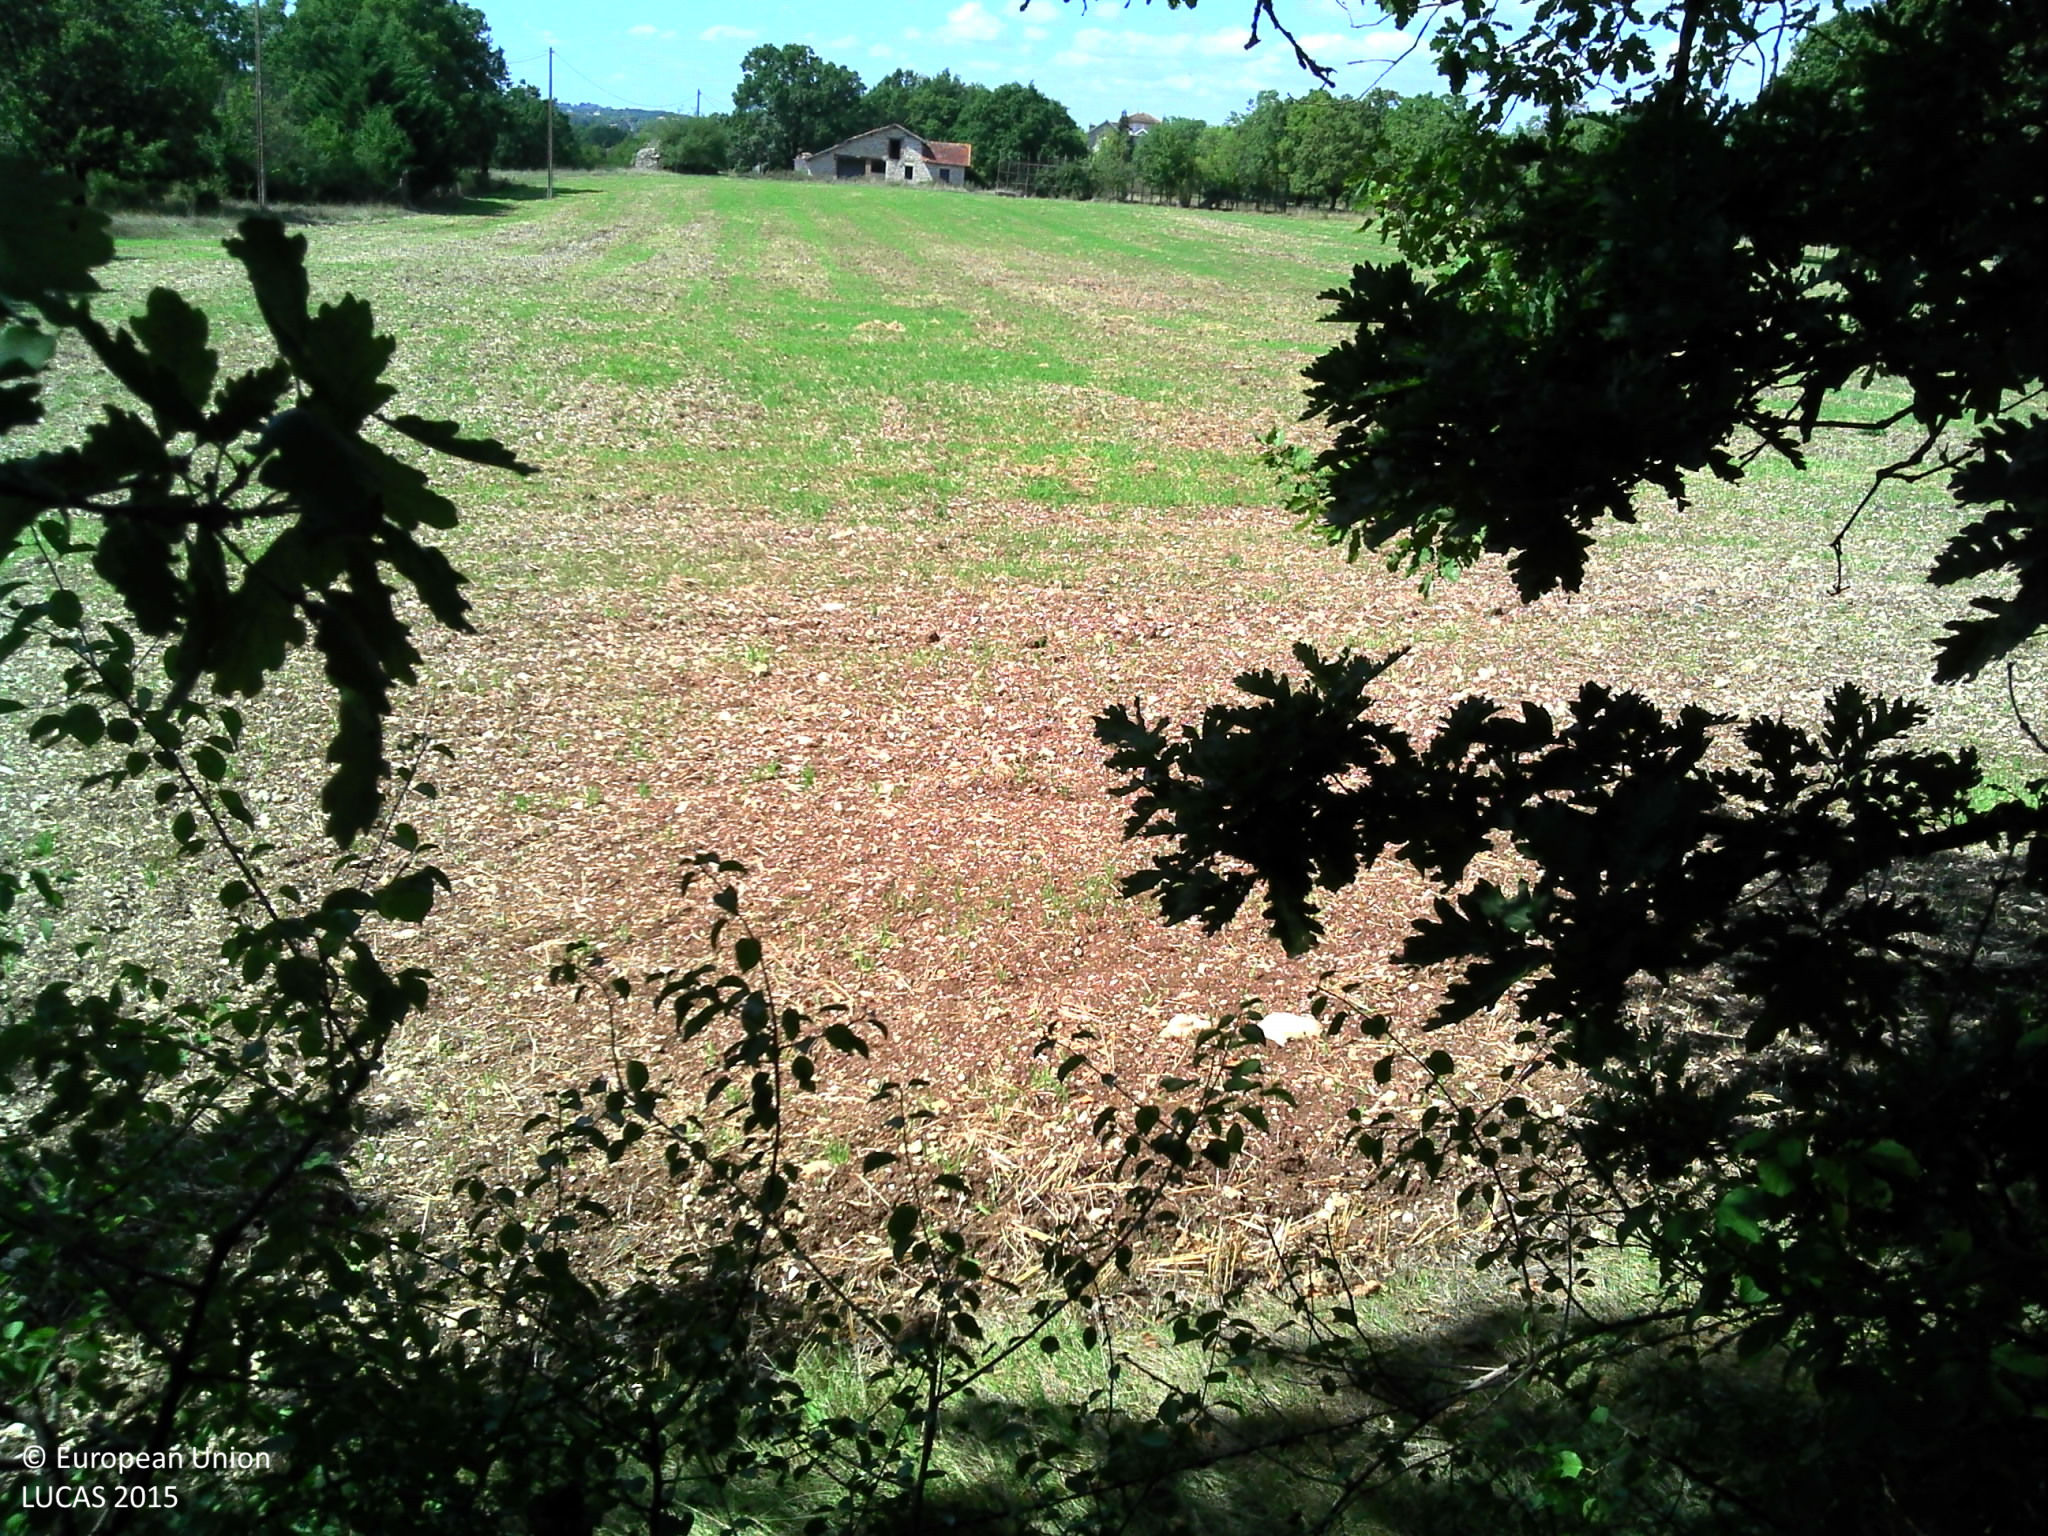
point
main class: Grassland
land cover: Spontaneously vegetated surfaces
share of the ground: 10 - 25 %
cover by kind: consolidated bare surface 75 %, herbaceous plants 25 %
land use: Agriculture (excluding fallow land and kitchen gardens)
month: August
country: FR
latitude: 44.2547
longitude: 1.4952
